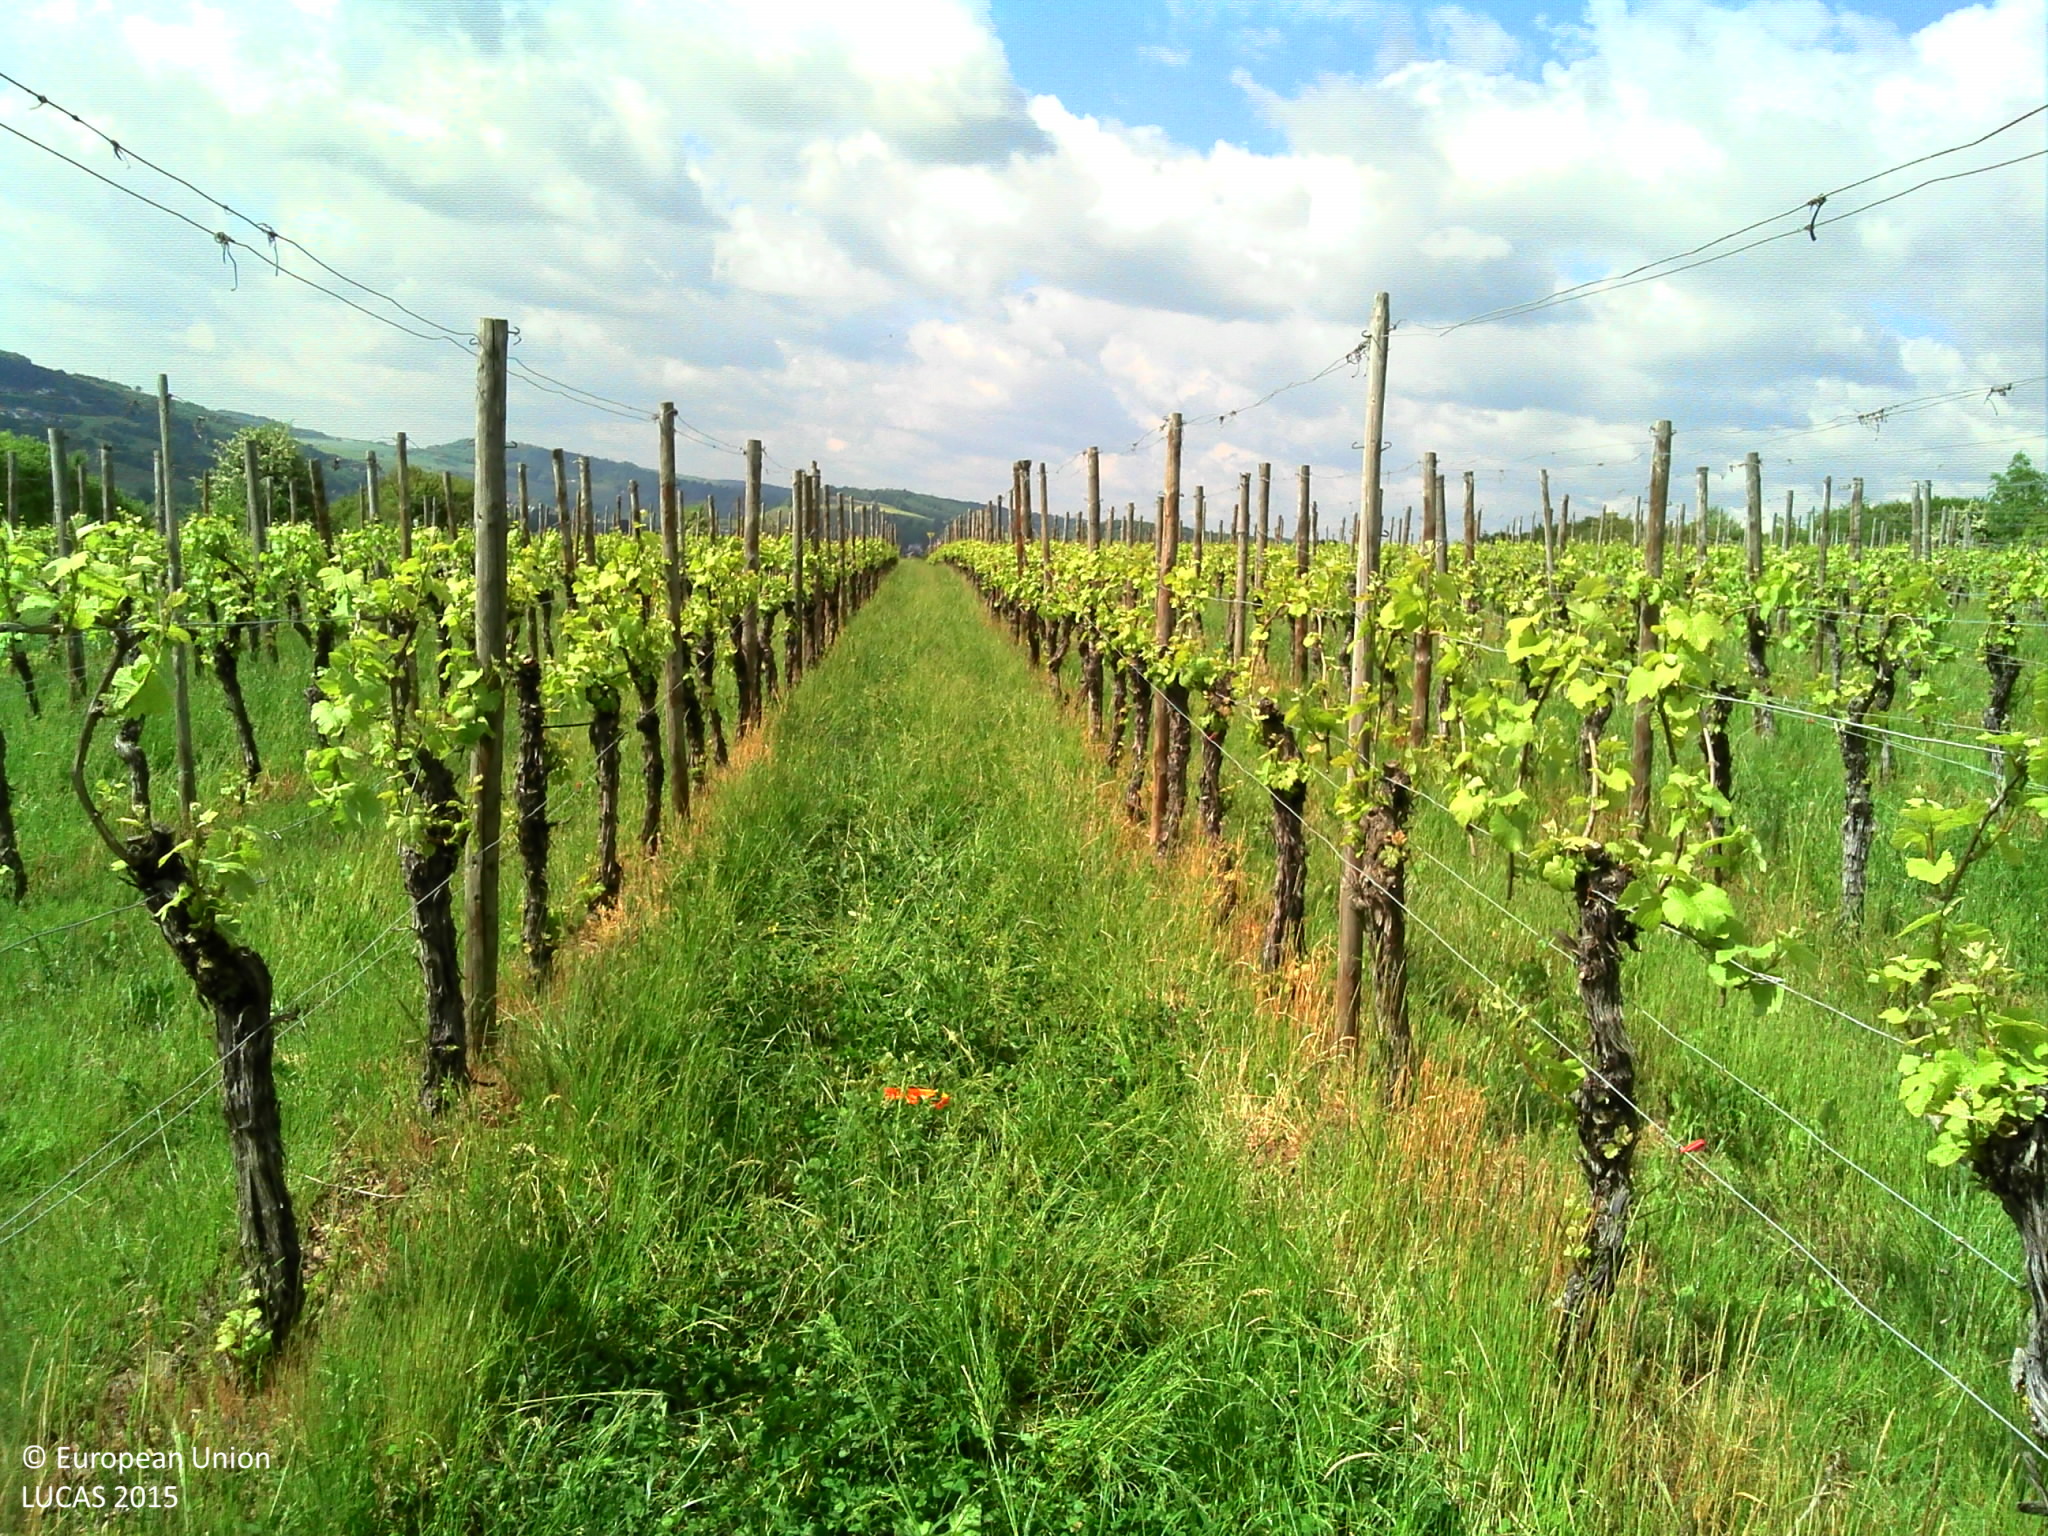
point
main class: Cropland
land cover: Vineyards
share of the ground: > 75 %
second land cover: Spontaneously vegetated surfaces
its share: > 75 %
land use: Agriculture (excluding fallow land and kitchen gardens)
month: May
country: LU
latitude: 49.6974
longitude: 6.4644
